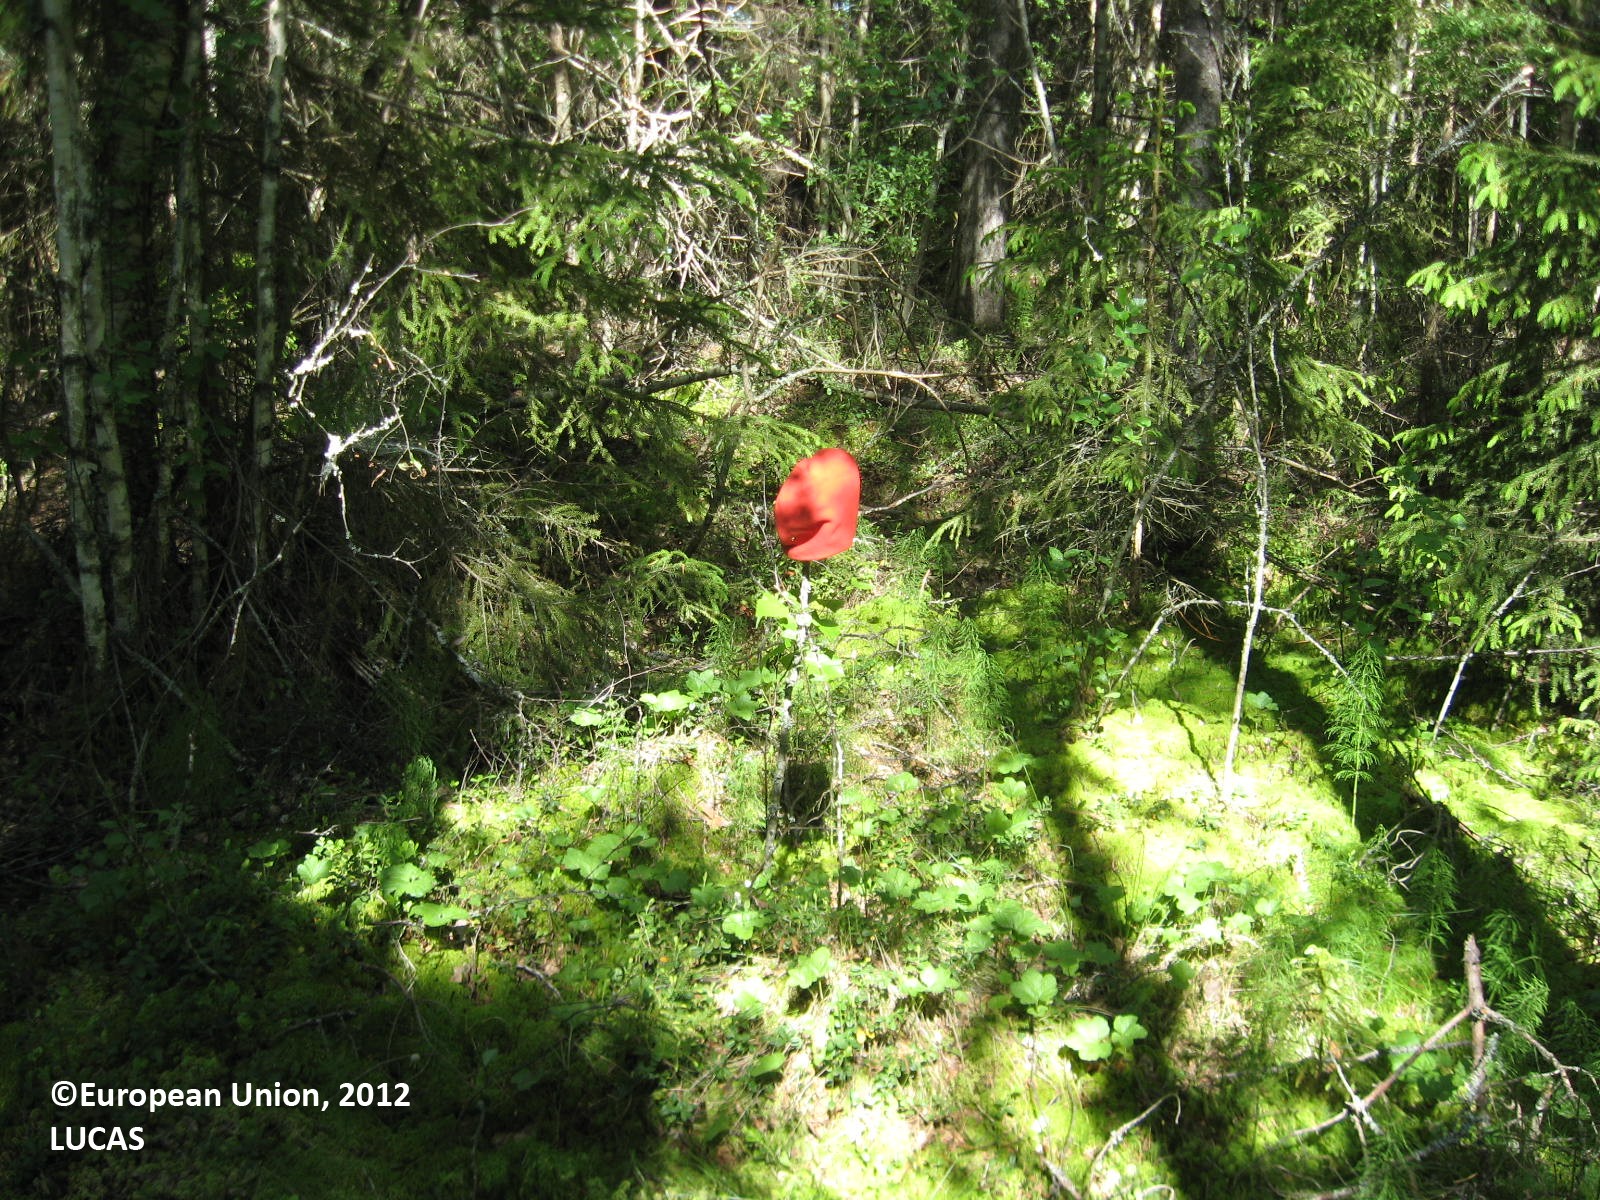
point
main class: Woodland
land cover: Other mixed woodland
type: boreal forest
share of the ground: > 75 %
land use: Forestry
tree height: > 5 m
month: June
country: FI
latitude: 62.7752
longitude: 21.2262
